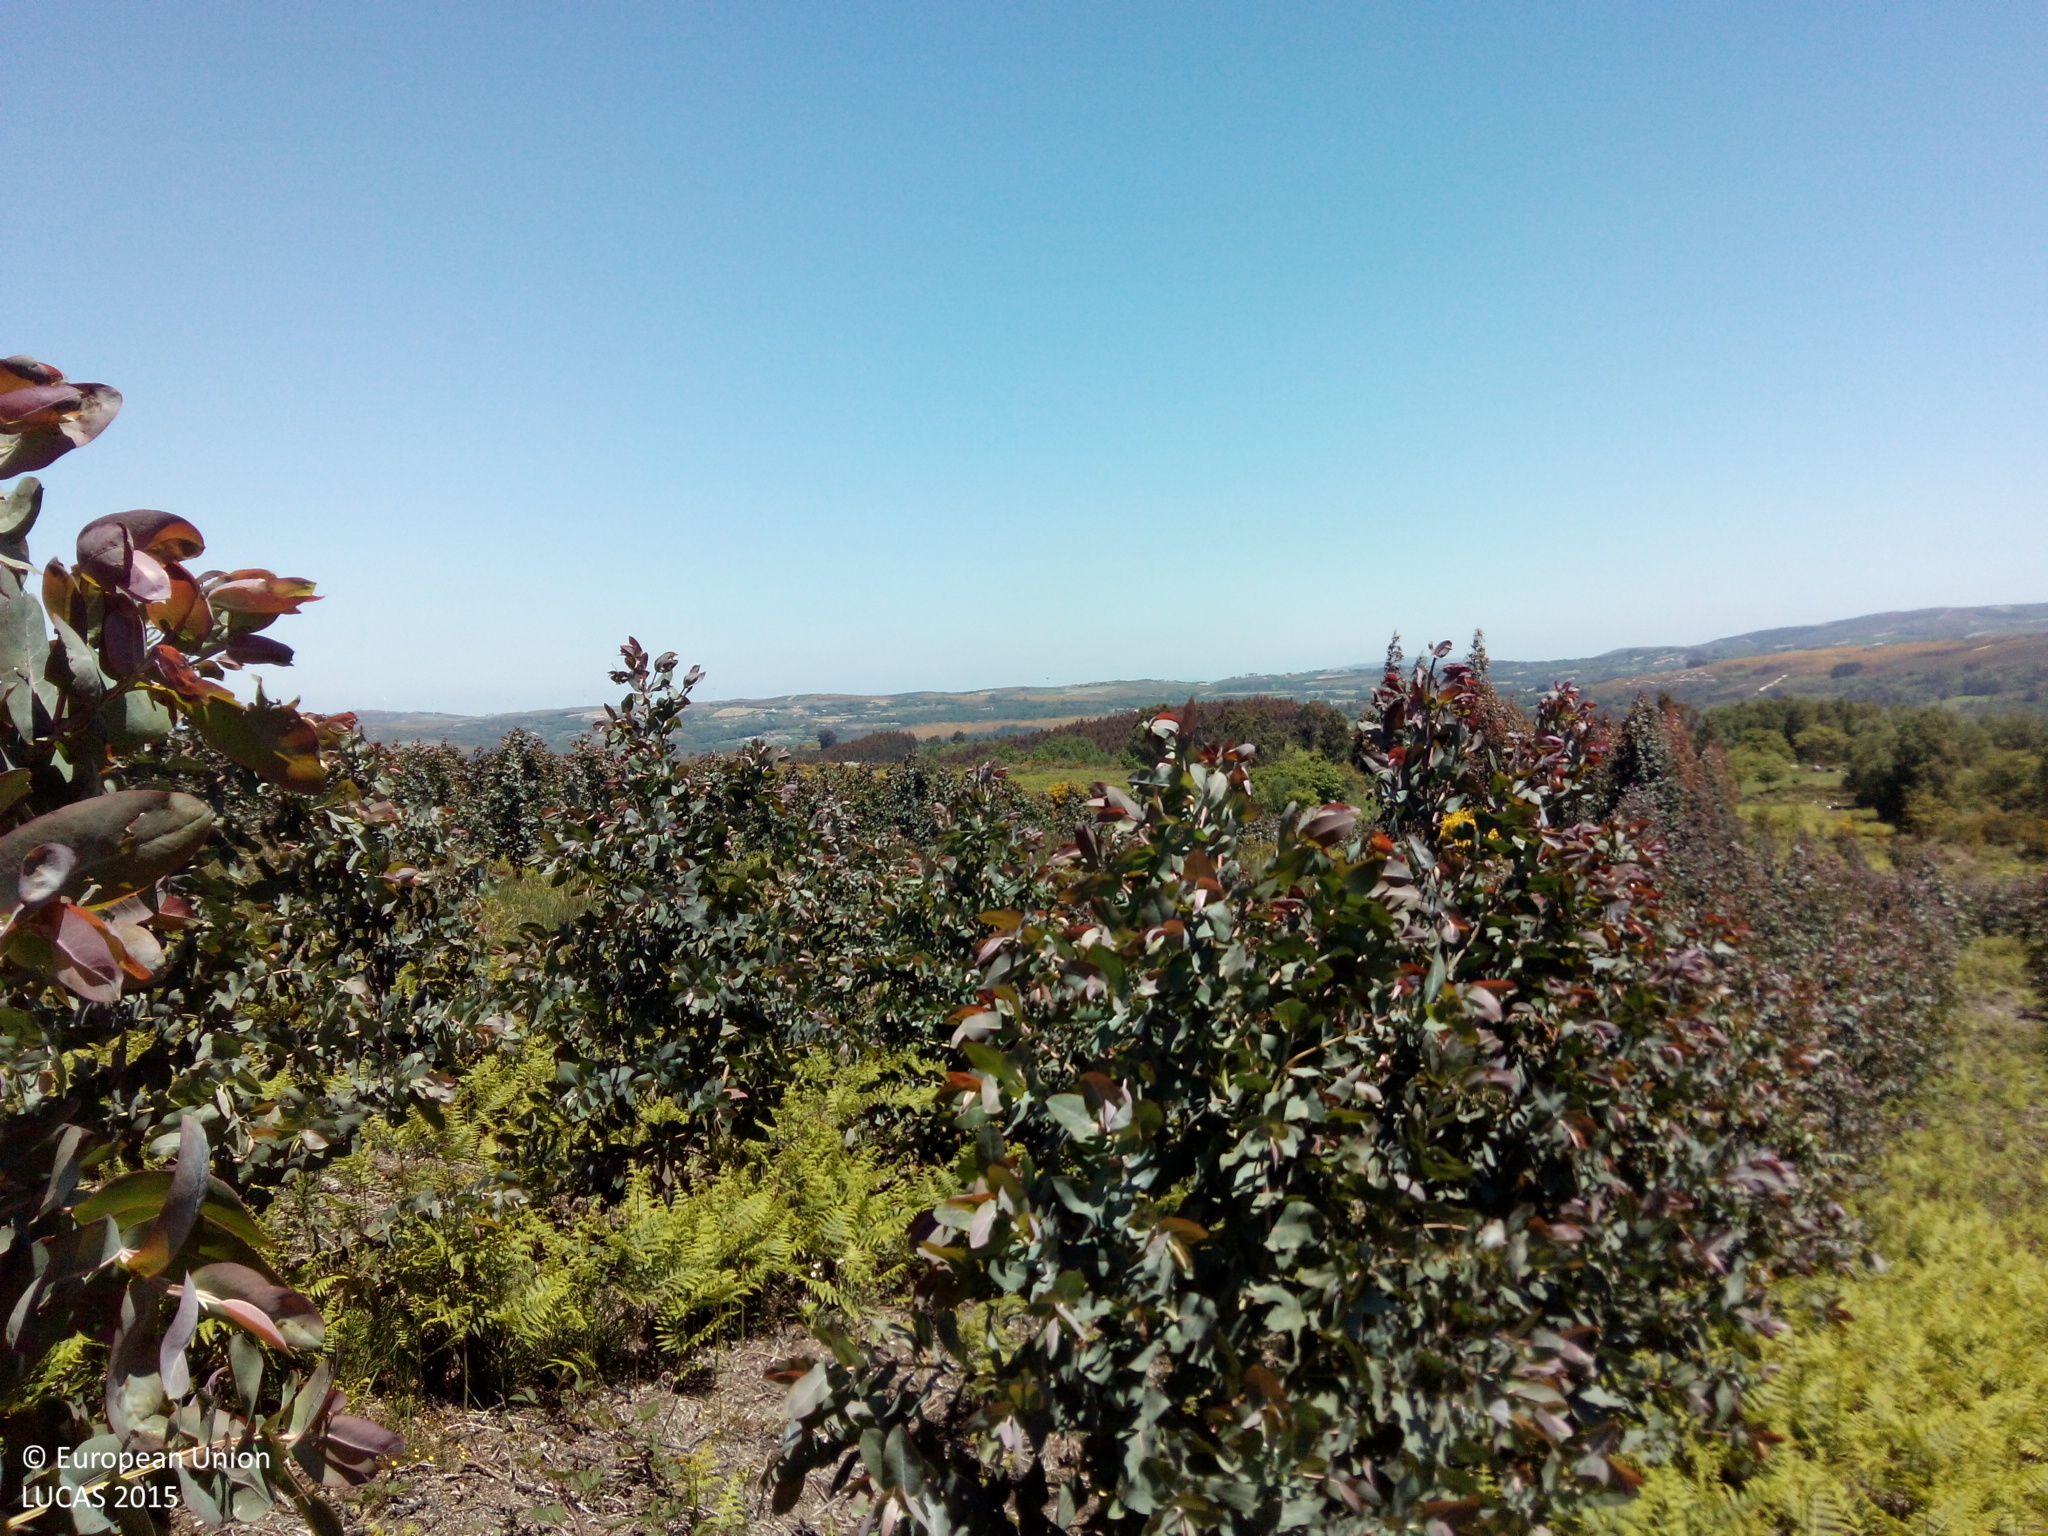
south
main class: Woodland
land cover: Broadleaved woodland
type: exotic forest
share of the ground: > 75 %
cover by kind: broadleaved forest trees 75 %, herbaceous plants 15 %, shrubs 10 %
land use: Forestry
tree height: < 5 m
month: May
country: ES
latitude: 42.6146
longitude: -8.3949
